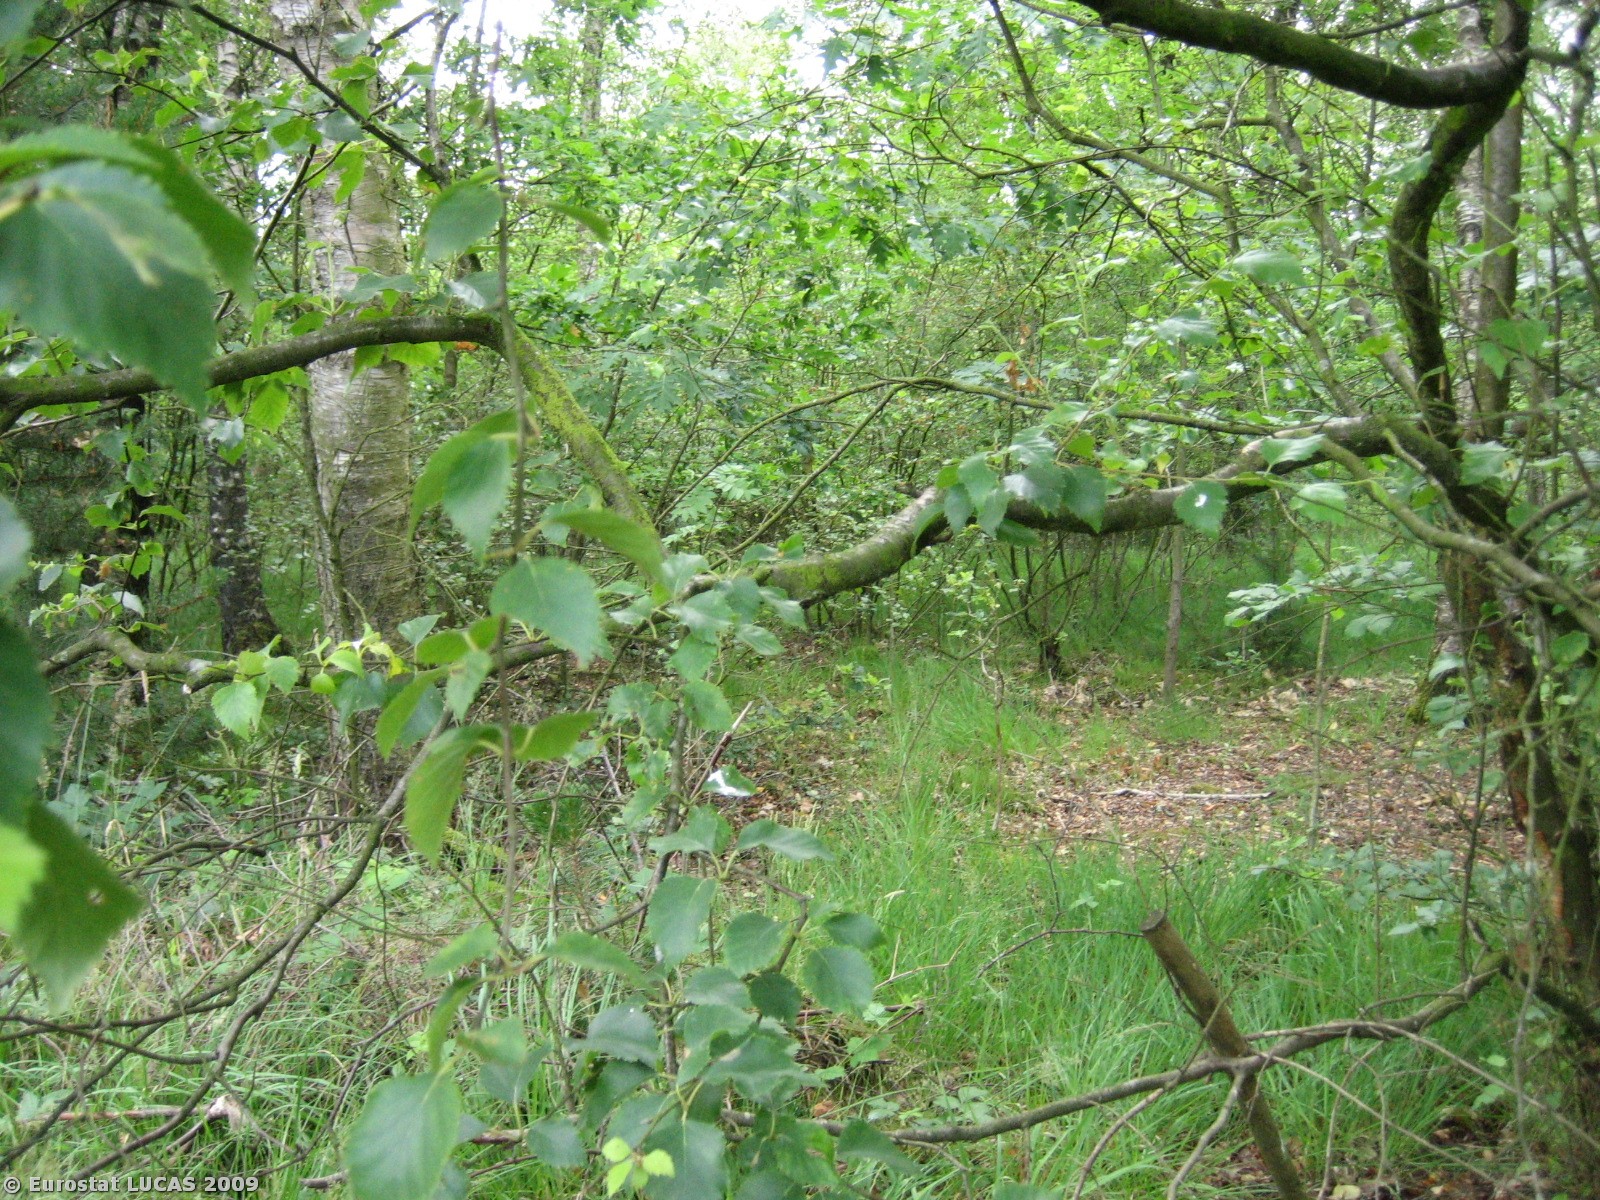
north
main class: Woodland
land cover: Mixed woodland
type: acidophilous oak and oak-birch forest
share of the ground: > 75 %
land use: Forestry
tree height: > 5 m
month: July
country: DK
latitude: 55.5489
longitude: 8.4322
